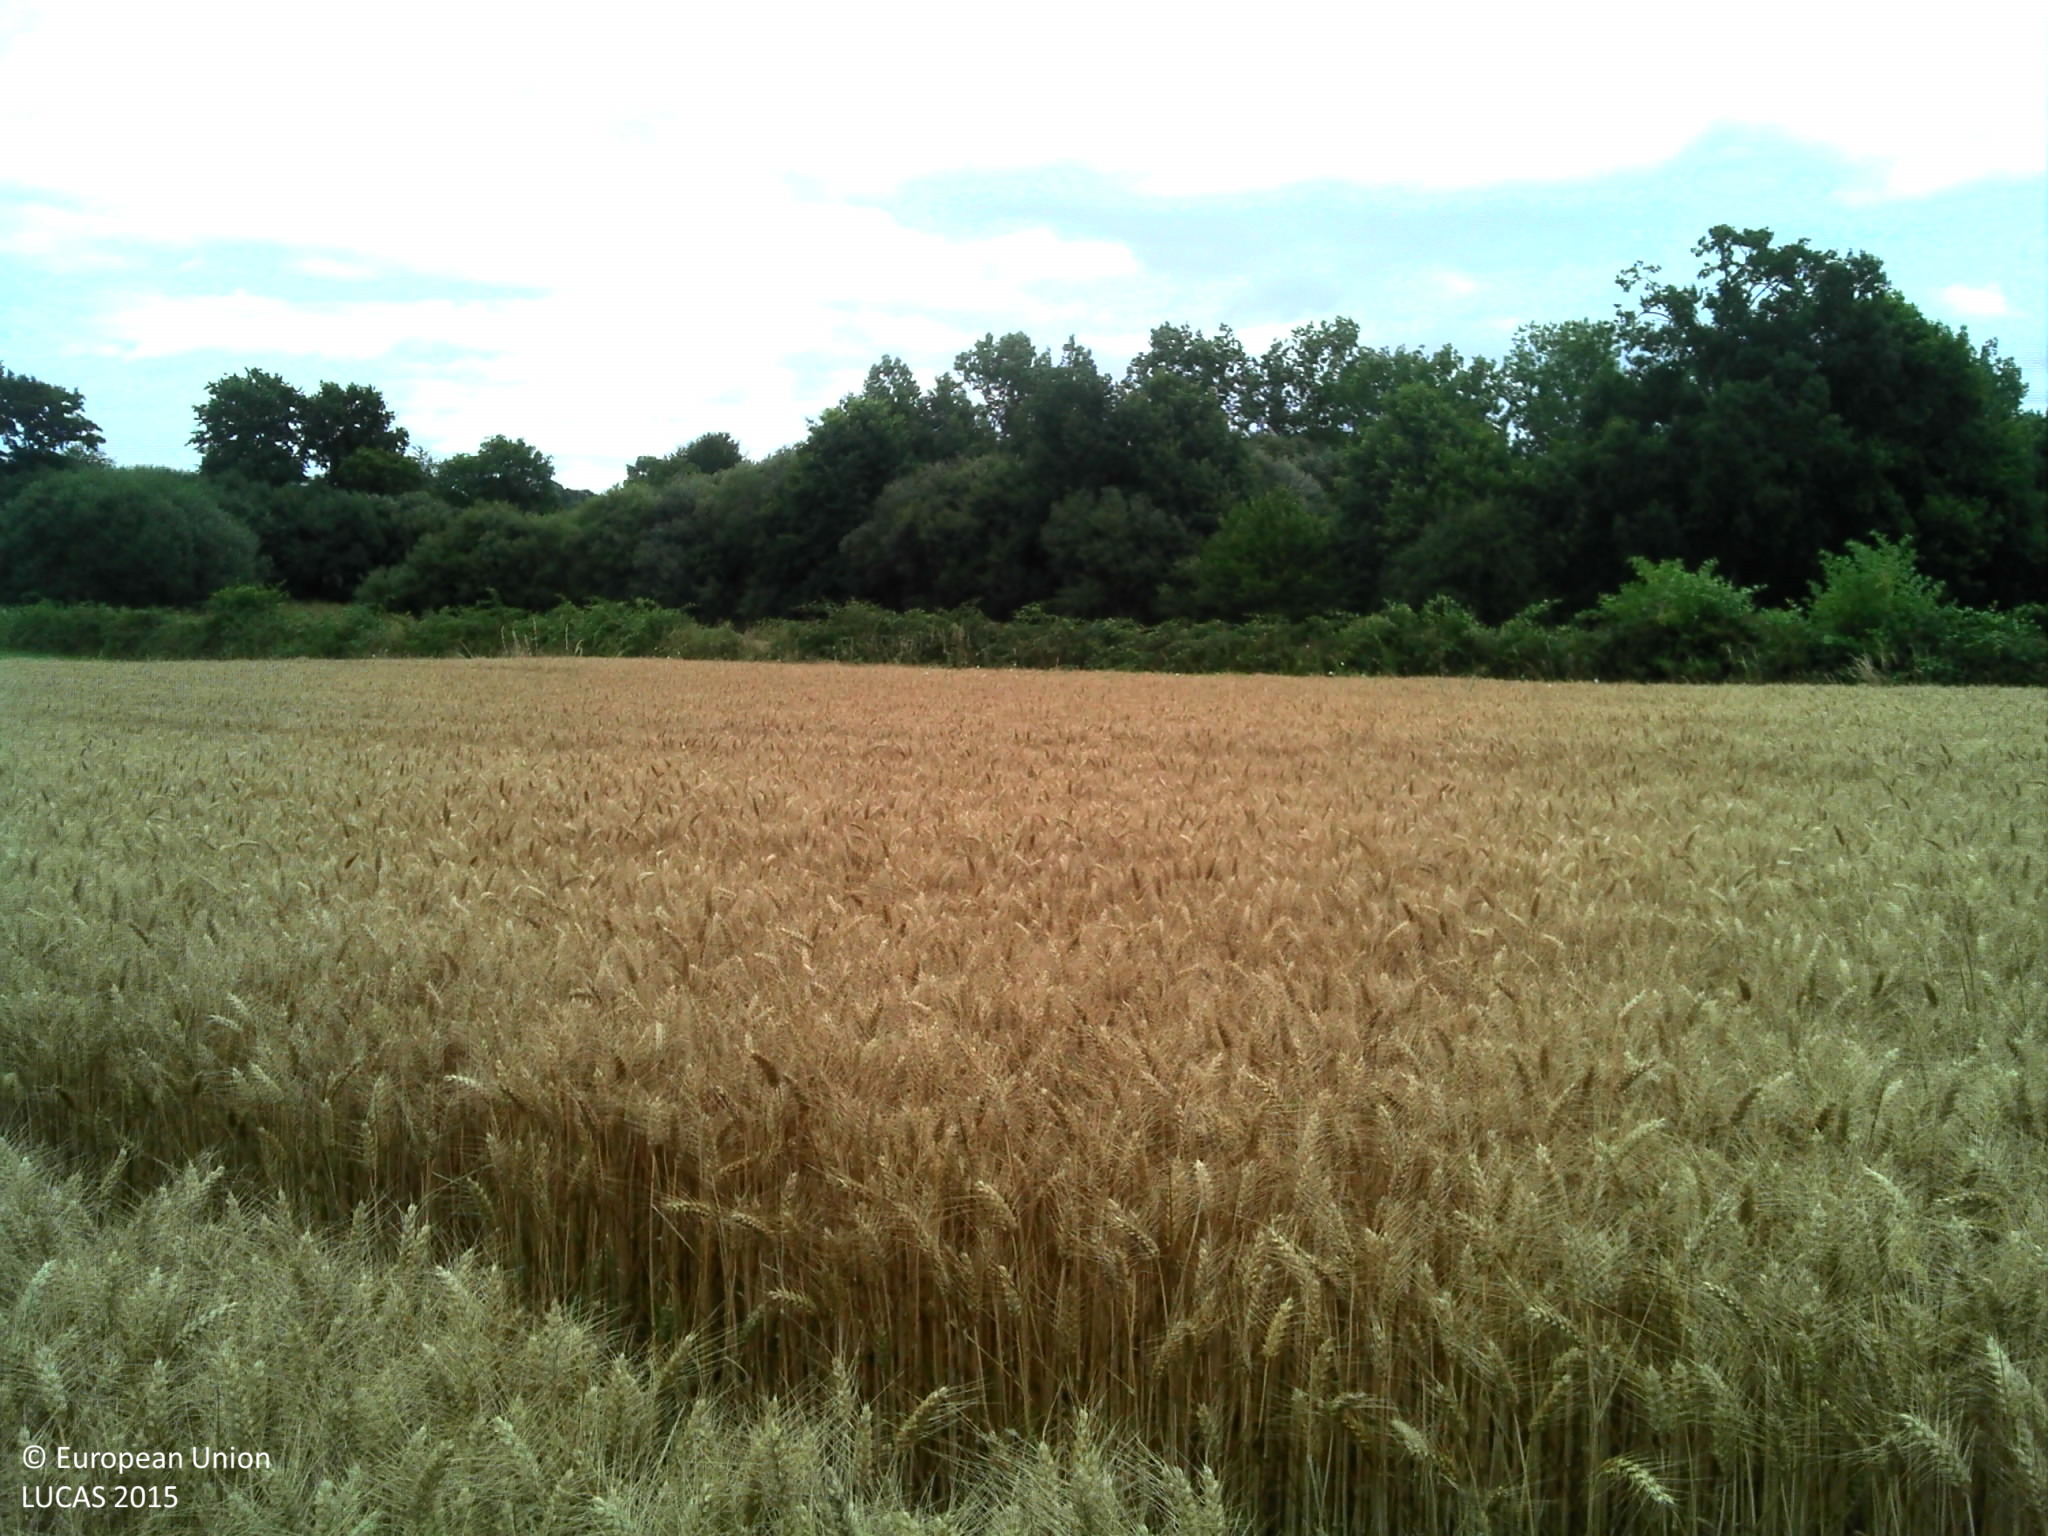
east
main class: Cropland
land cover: Durum wheat
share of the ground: > 75 %
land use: Agriculture (excluding fallow land and kitchen gardens)
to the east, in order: Durum wheat; Electric lines; Durum wheat; Managed hedges; Durum wheat; Broadleaved woodland; Grassland without tree/shrub cover; Broadleaved woodland; Common wheat; Grass margins; Tracks; Grass margins; Abandoned hedges
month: July
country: FR
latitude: 47.7959
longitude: -2.0536
